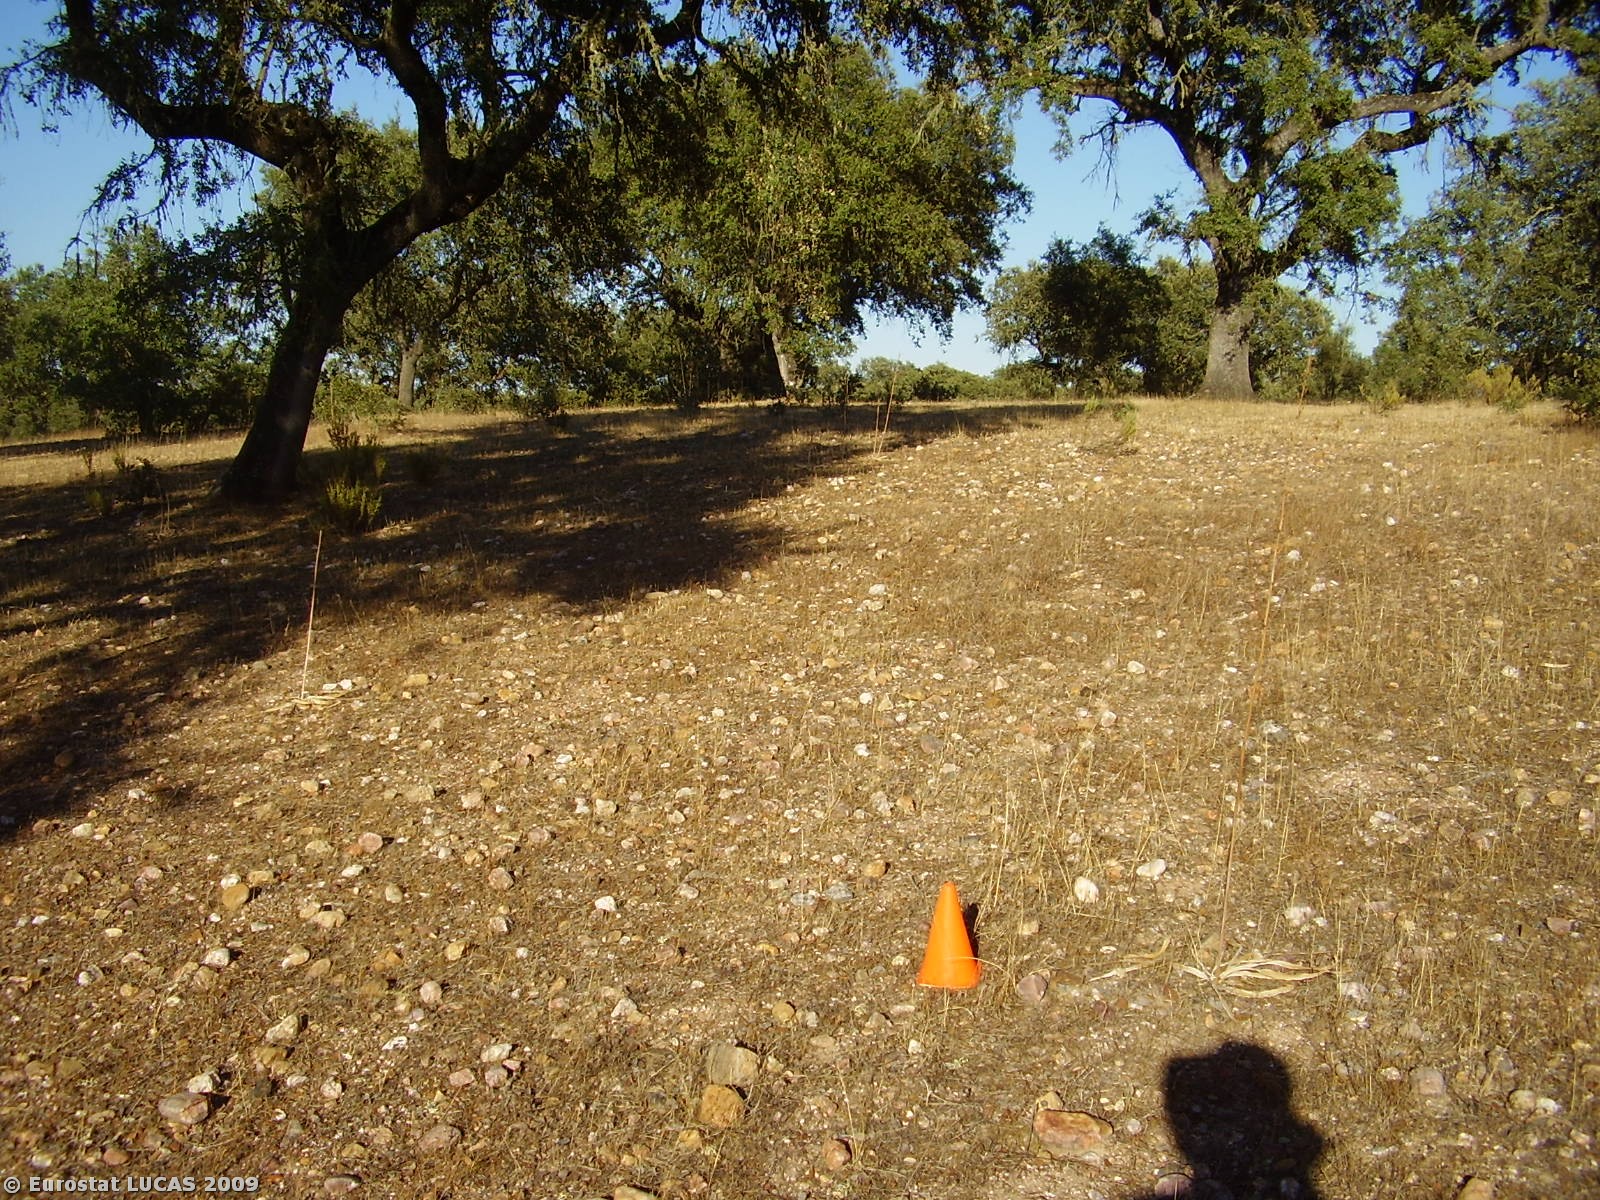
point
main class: Woodland
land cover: Broadleaved woodland
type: broadleaved evergreen forest
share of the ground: 25 - 50 %
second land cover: Spontaneously vegetated surfaces
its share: 10 - 25 %
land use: Forestry
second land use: Fallow land
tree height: > 5 m
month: July
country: PT
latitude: 38.9318
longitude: -8.0335
